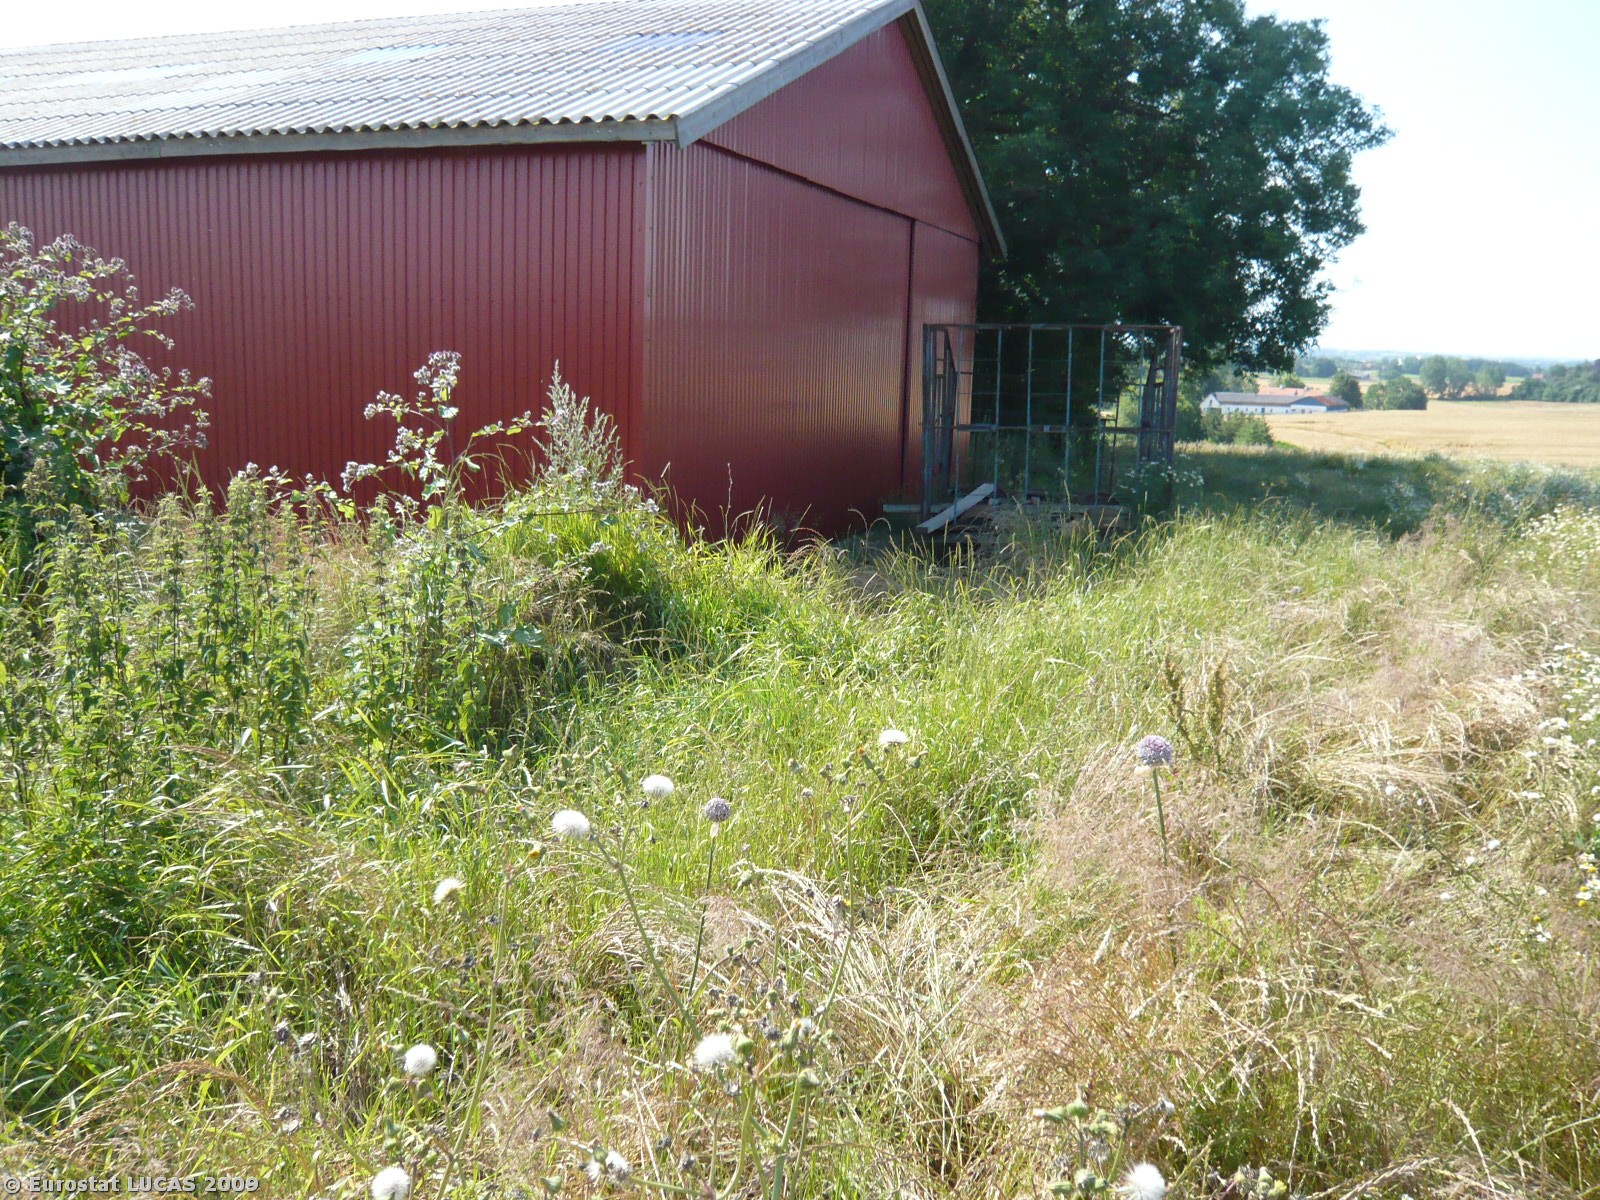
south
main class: Cropland
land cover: Rape and turnip rape
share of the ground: > 75 %
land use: Agriculture (excluding fallow land and kitchen gardens)
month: July
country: DK
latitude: 55.8200
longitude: 11.4510
